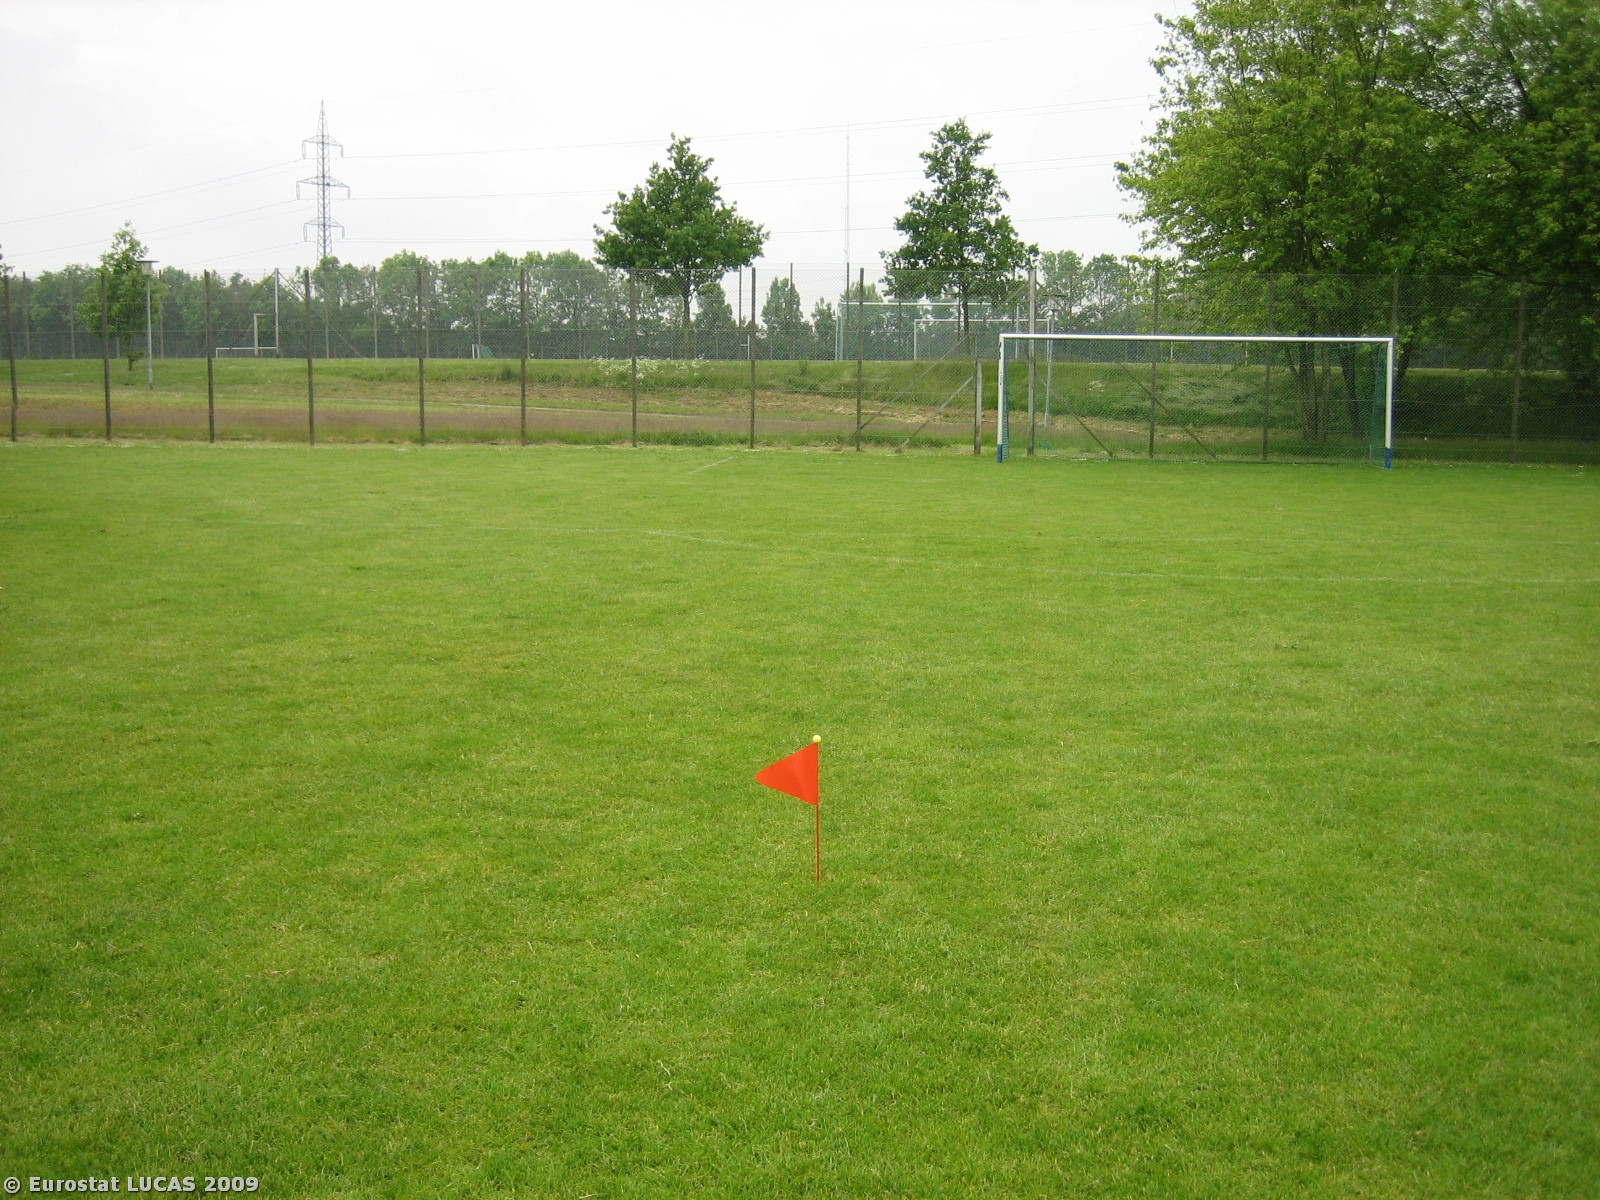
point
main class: Grassland
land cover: Grassland without tree/shrub cover
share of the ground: > 75 %
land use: Sport
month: June
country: DK
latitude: 56.1697
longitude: 10.1448
